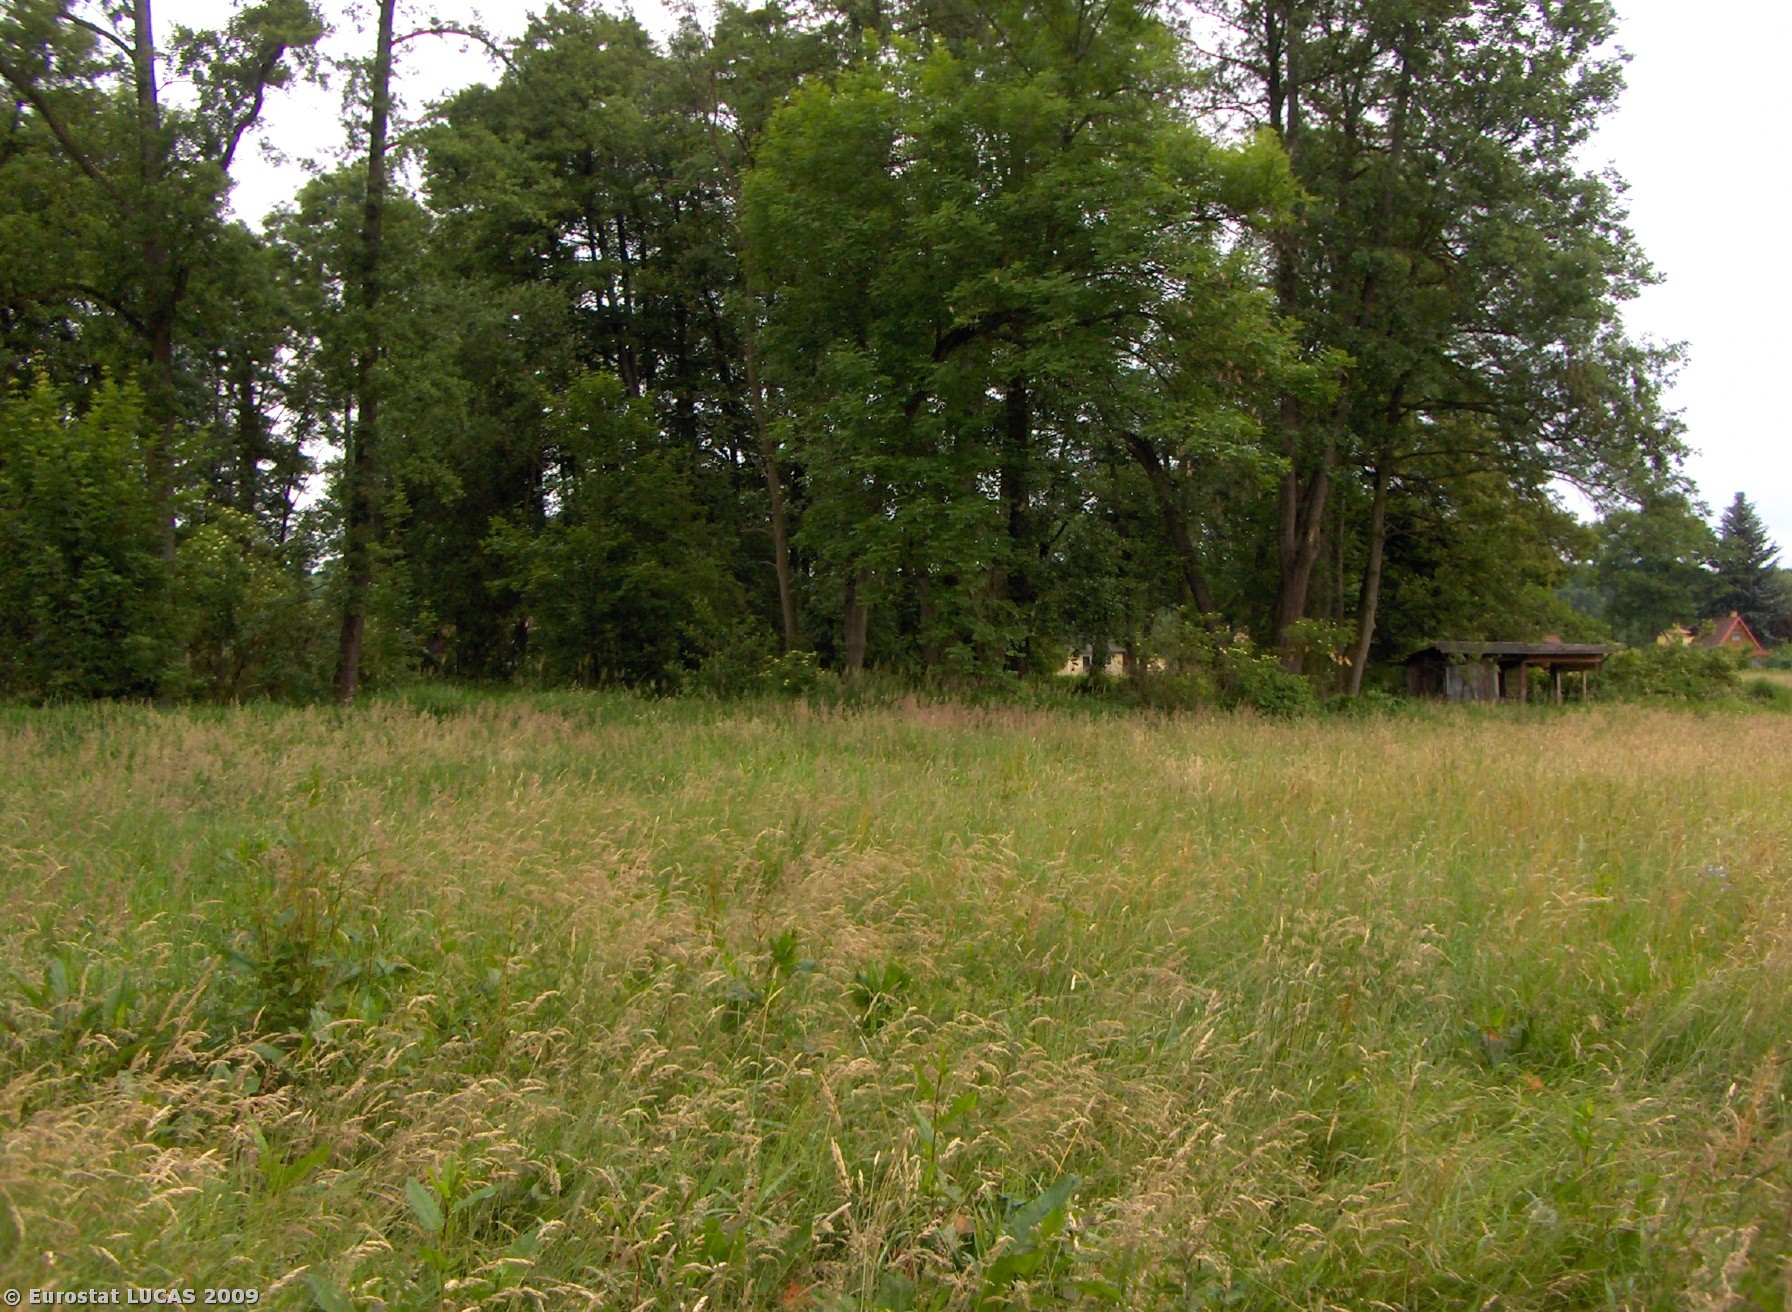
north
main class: Grassland
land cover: Grassland without tree/shrub cover
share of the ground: > 75 %
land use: Agriculture (excluding fallow land and kitchen gardens)
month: June
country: CZ
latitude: 49.1531
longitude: 14.1826
